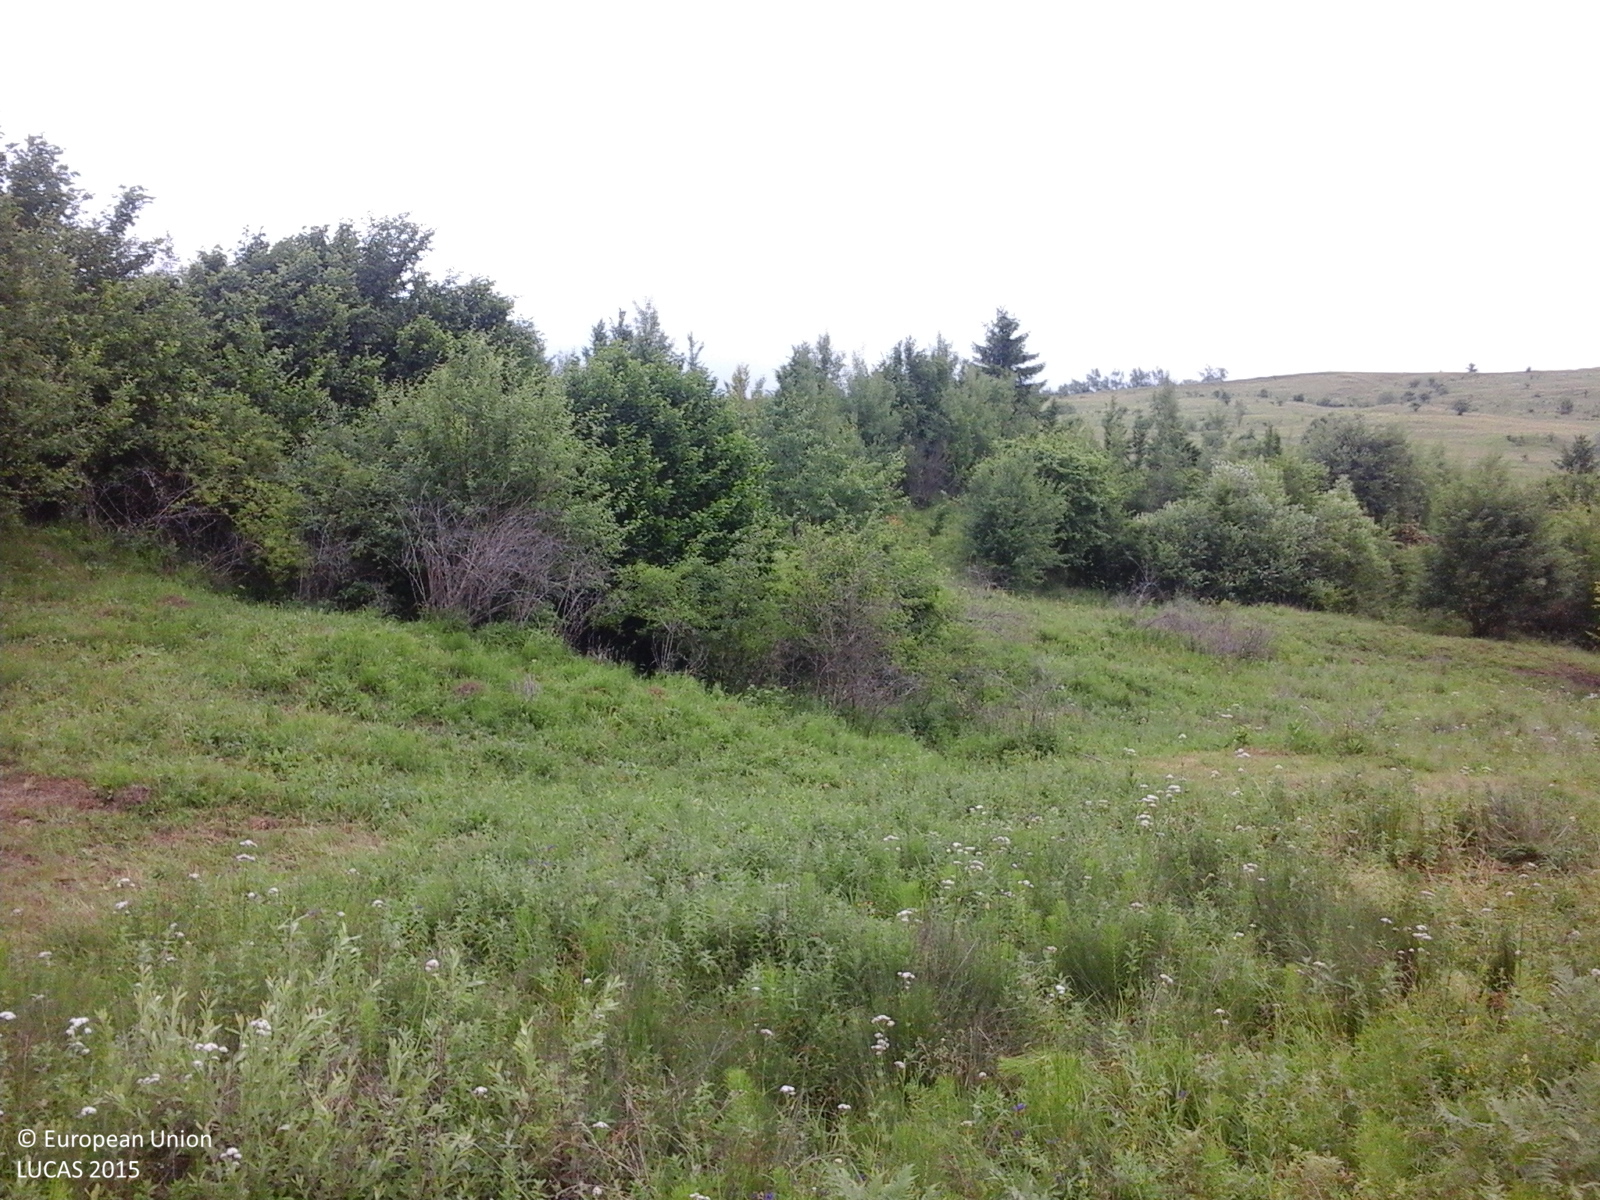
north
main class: Grassland
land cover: Spontaneously vegetated surfaces
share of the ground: > 75 %
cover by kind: herbaceous plants 100 %
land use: Agriculture (excluding fallow land and kitchen gardens)
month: June
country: RO
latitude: 47.3389
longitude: 26.2406
